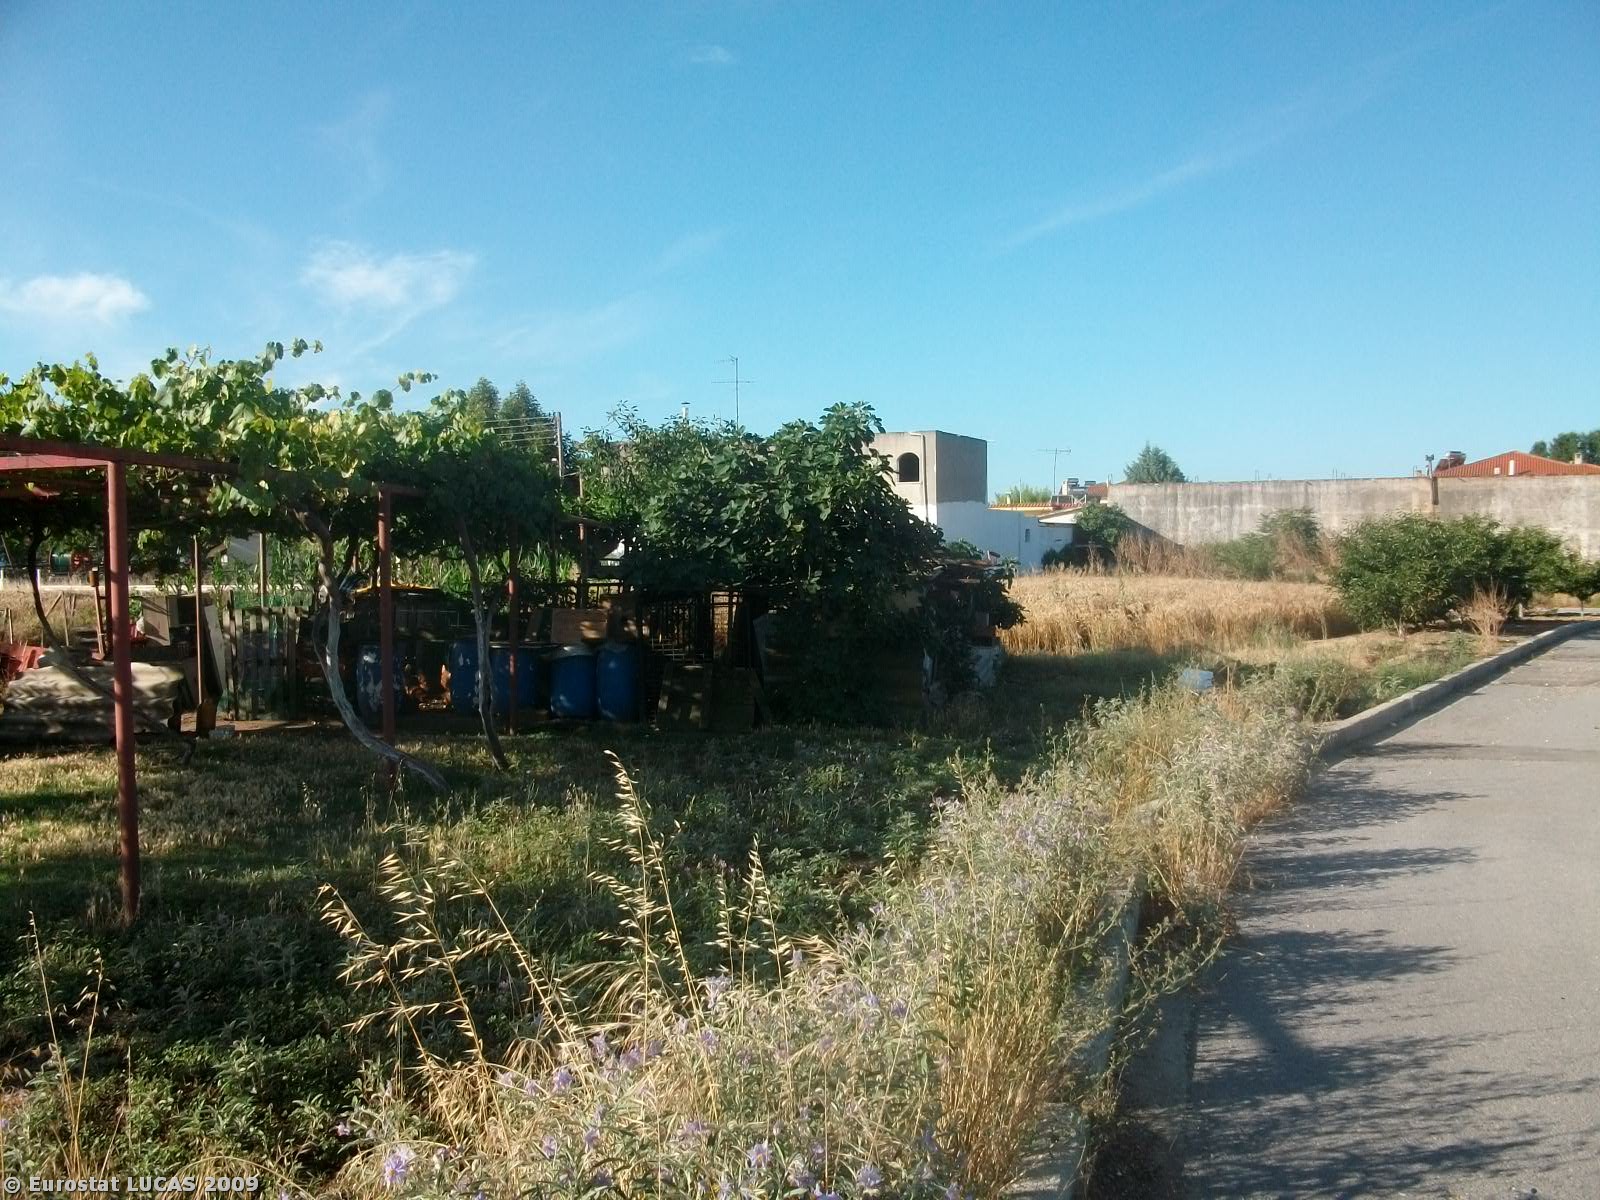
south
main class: Cropland
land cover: Oats
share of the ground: > 75 %
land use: Agriculture (excluding fallow land and kitchen gardens)
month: June
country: GR
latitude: 40.7204
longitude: 22.6843
